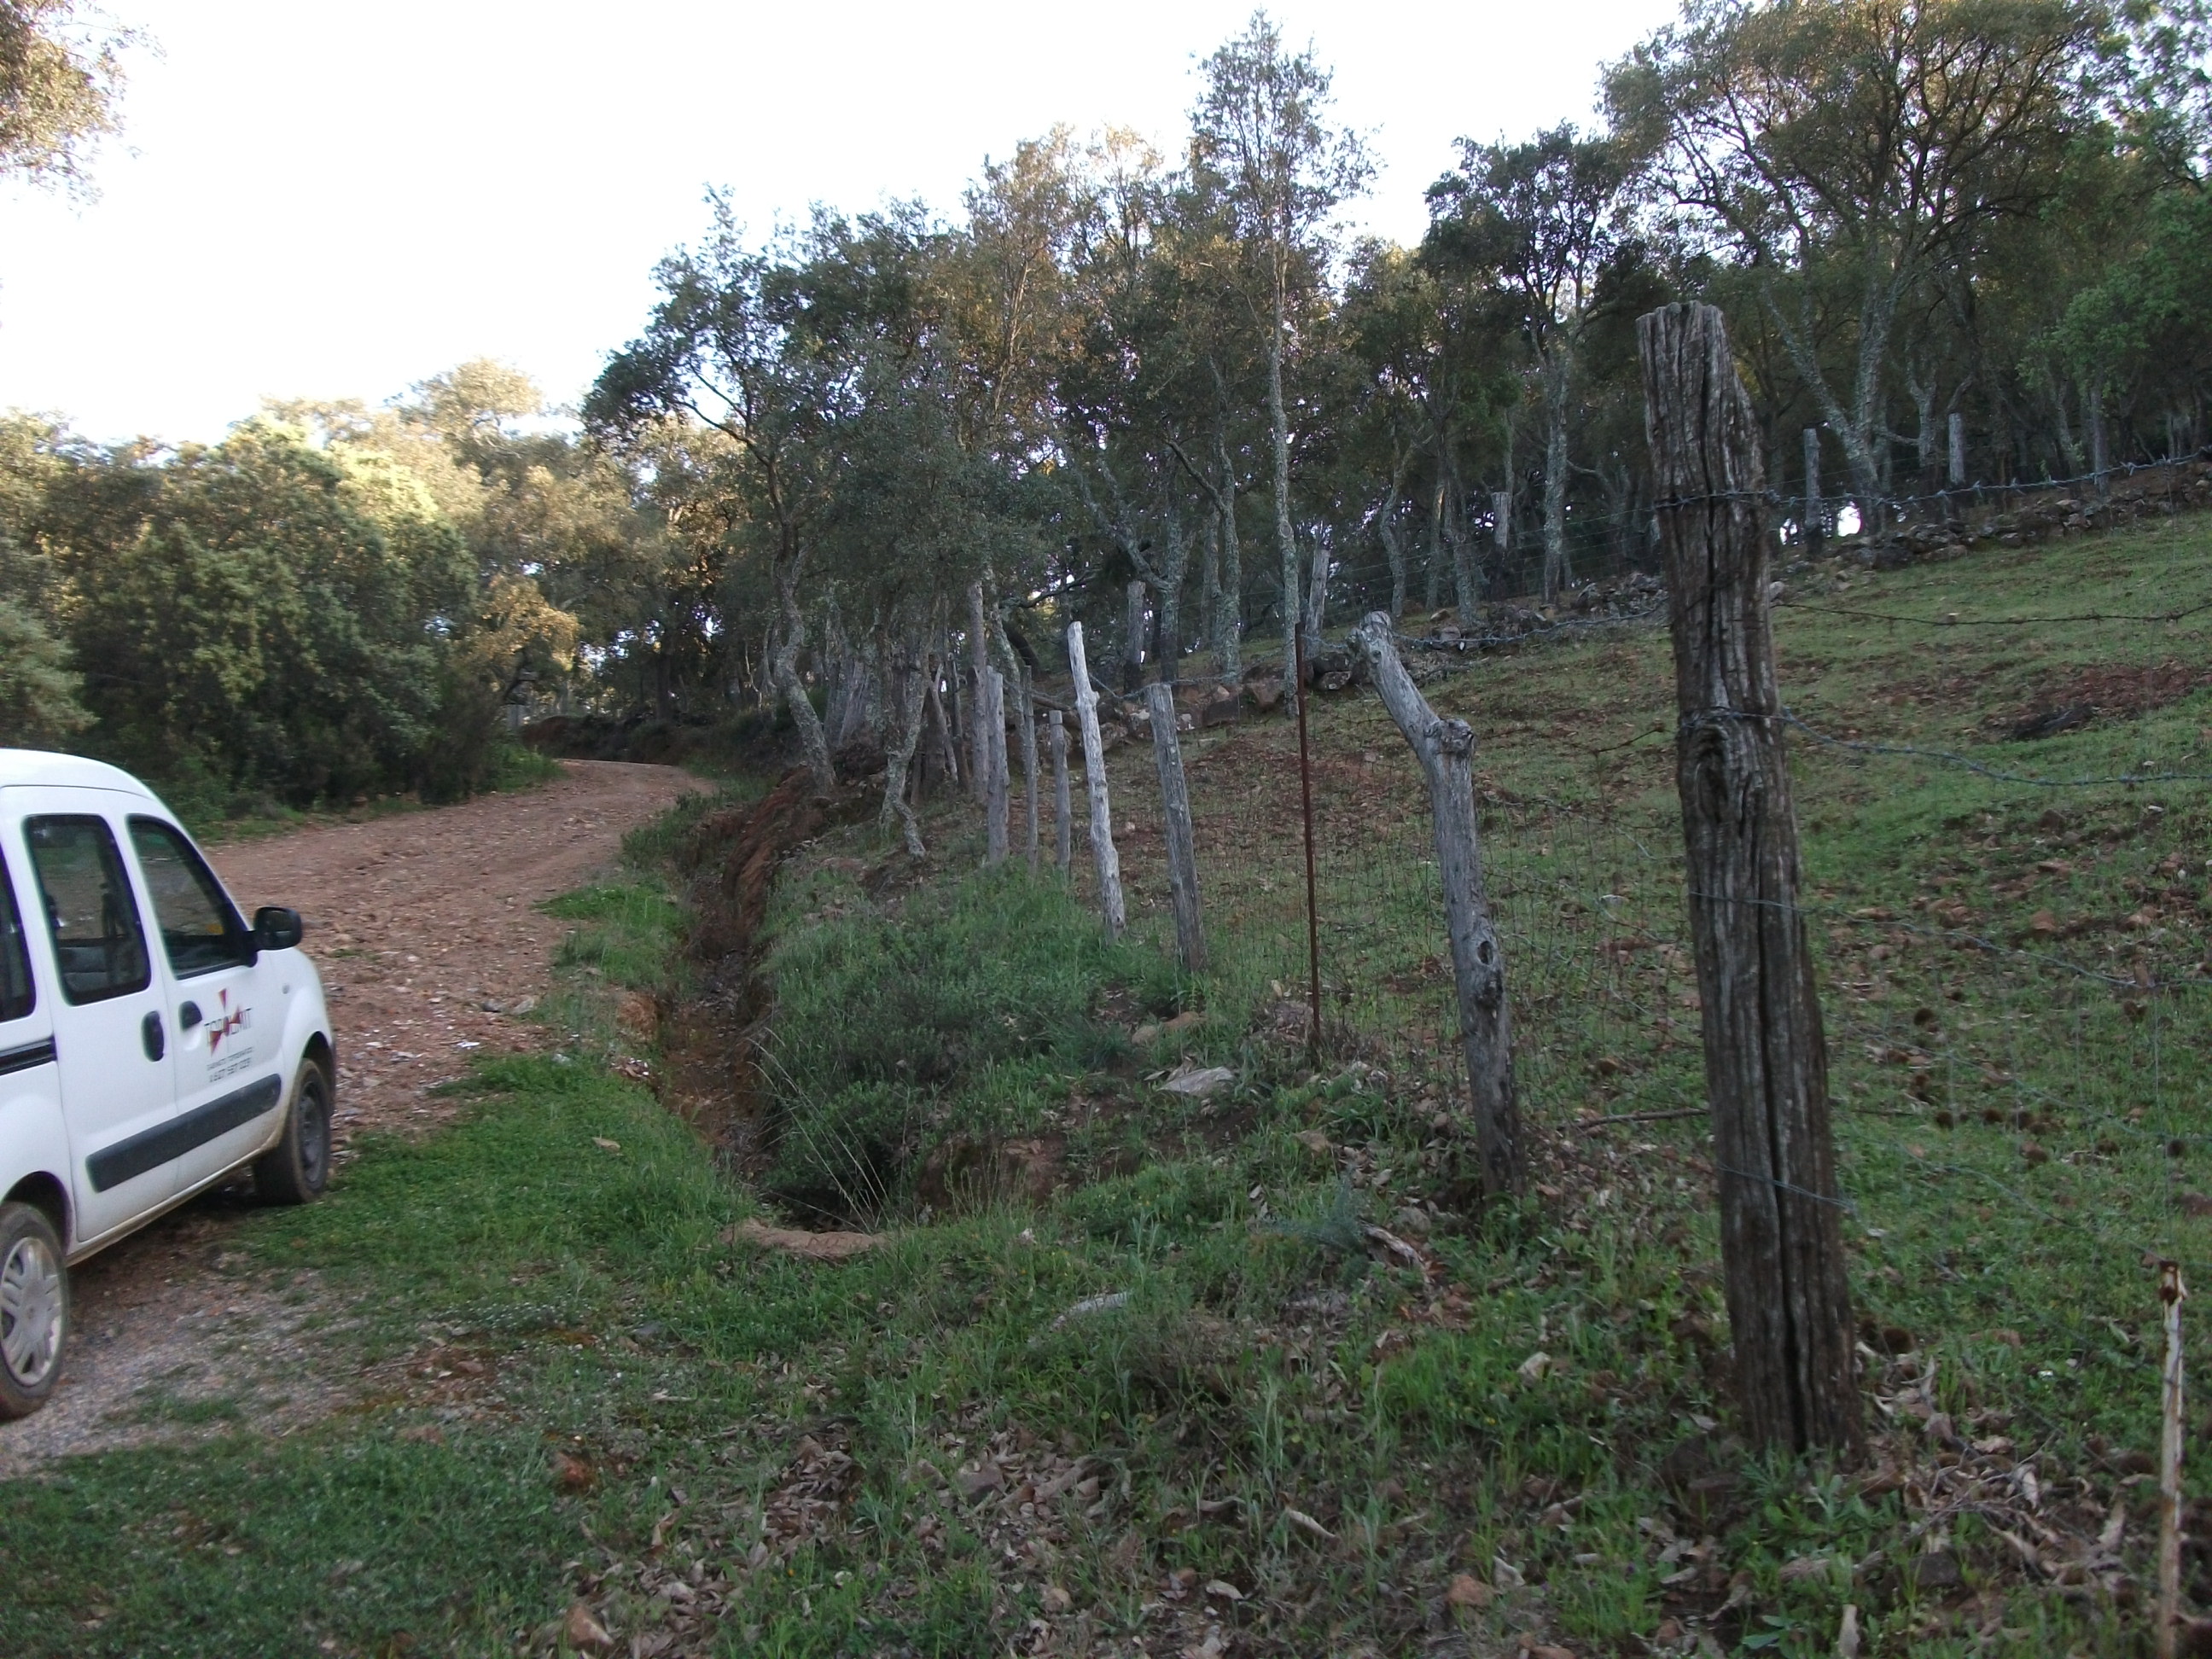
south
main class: Woodland
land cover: Broadleaved woodland
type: broadleaved evergreen forest
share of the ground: 50 - 75 %
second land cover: Grassland without tree/shrub cover
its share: > 75 %
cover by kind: broadleaved forest trees 70 %, herbaceous plants 30 %
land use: Forestry
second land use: Agriculture (excluding fallow land and kitchen gardens)
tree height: > 5 m
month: April
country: ES
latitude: 37.8619
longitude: -6.7207
